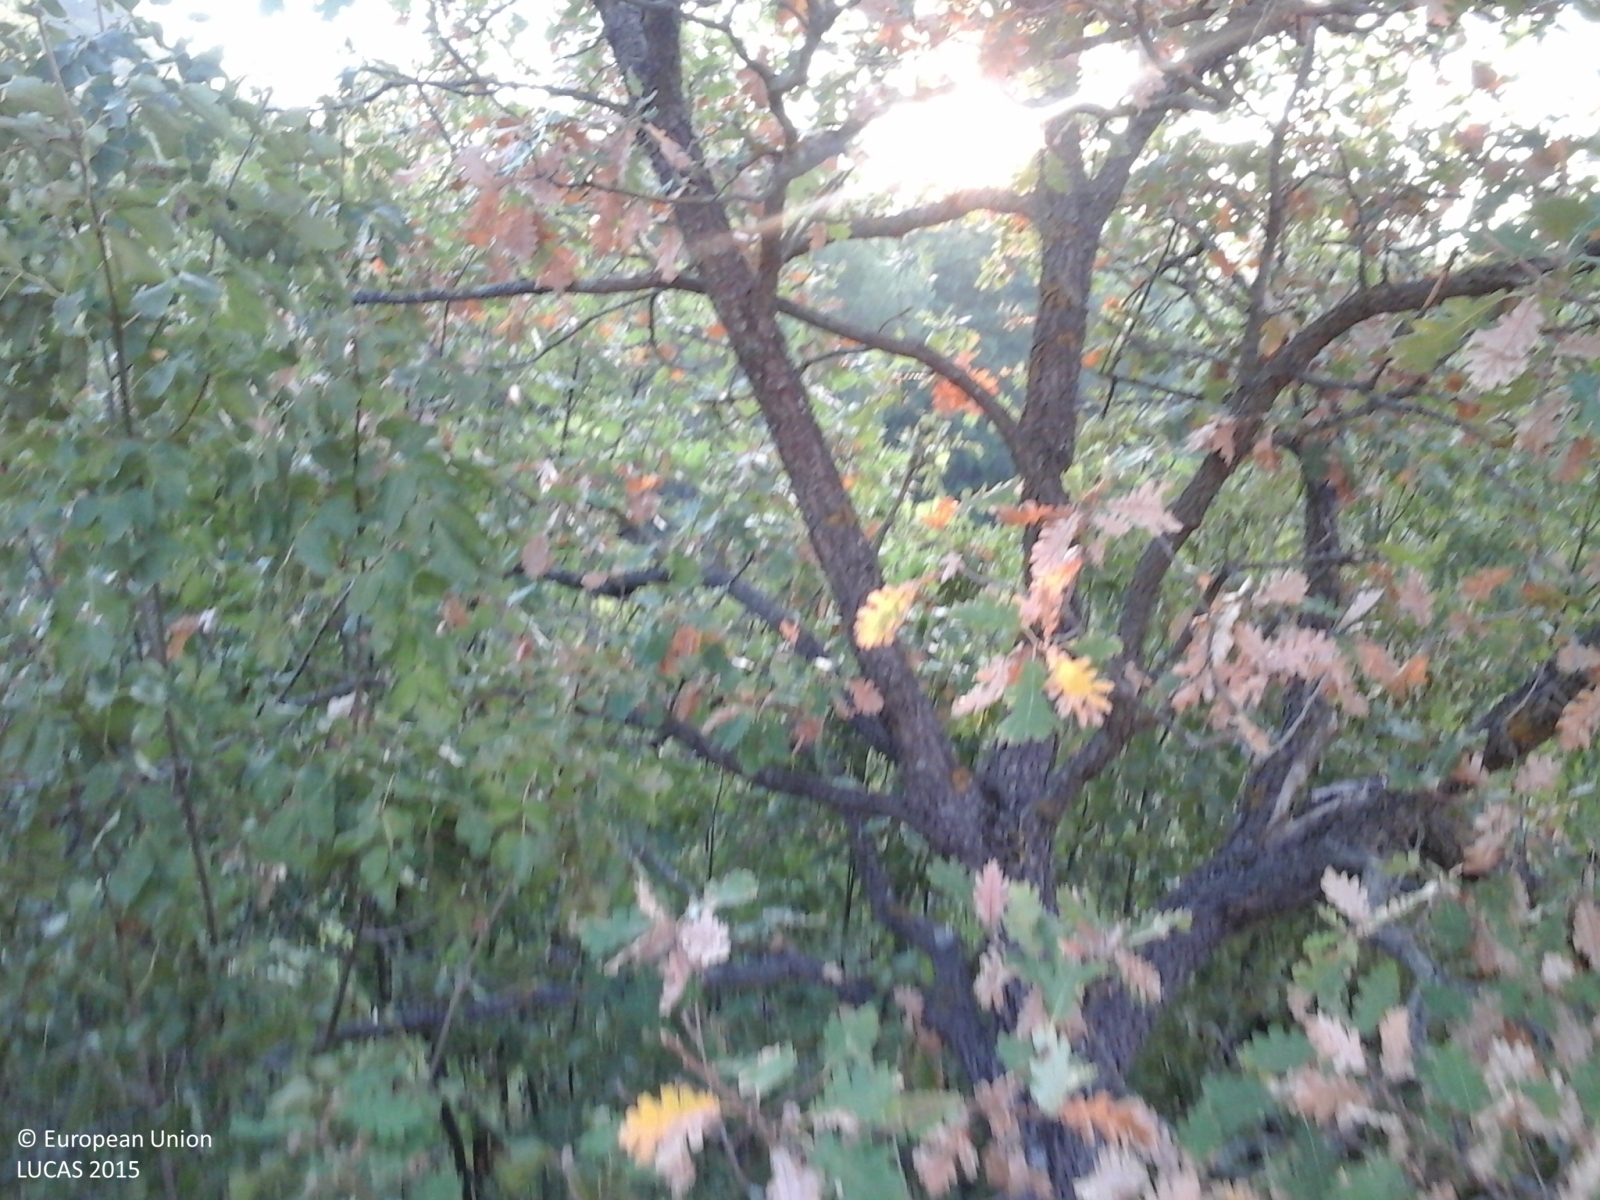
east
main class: Woodland
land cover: Broadleaved woodland
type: thermophilous deciduous forest
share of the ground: > 75 %
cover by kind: broadleaved forest trees 100 %
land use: Forestry
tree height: > 5 m
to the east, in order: Broadleaved woodland; Durum wheat; Electric lines; Durum wheat; Grass margins; Paved roads, cycling and walking lanes; Grass margins; Managed hedges; Lucerne
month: August
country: IT
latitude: 43.6151
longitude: 12.5584
